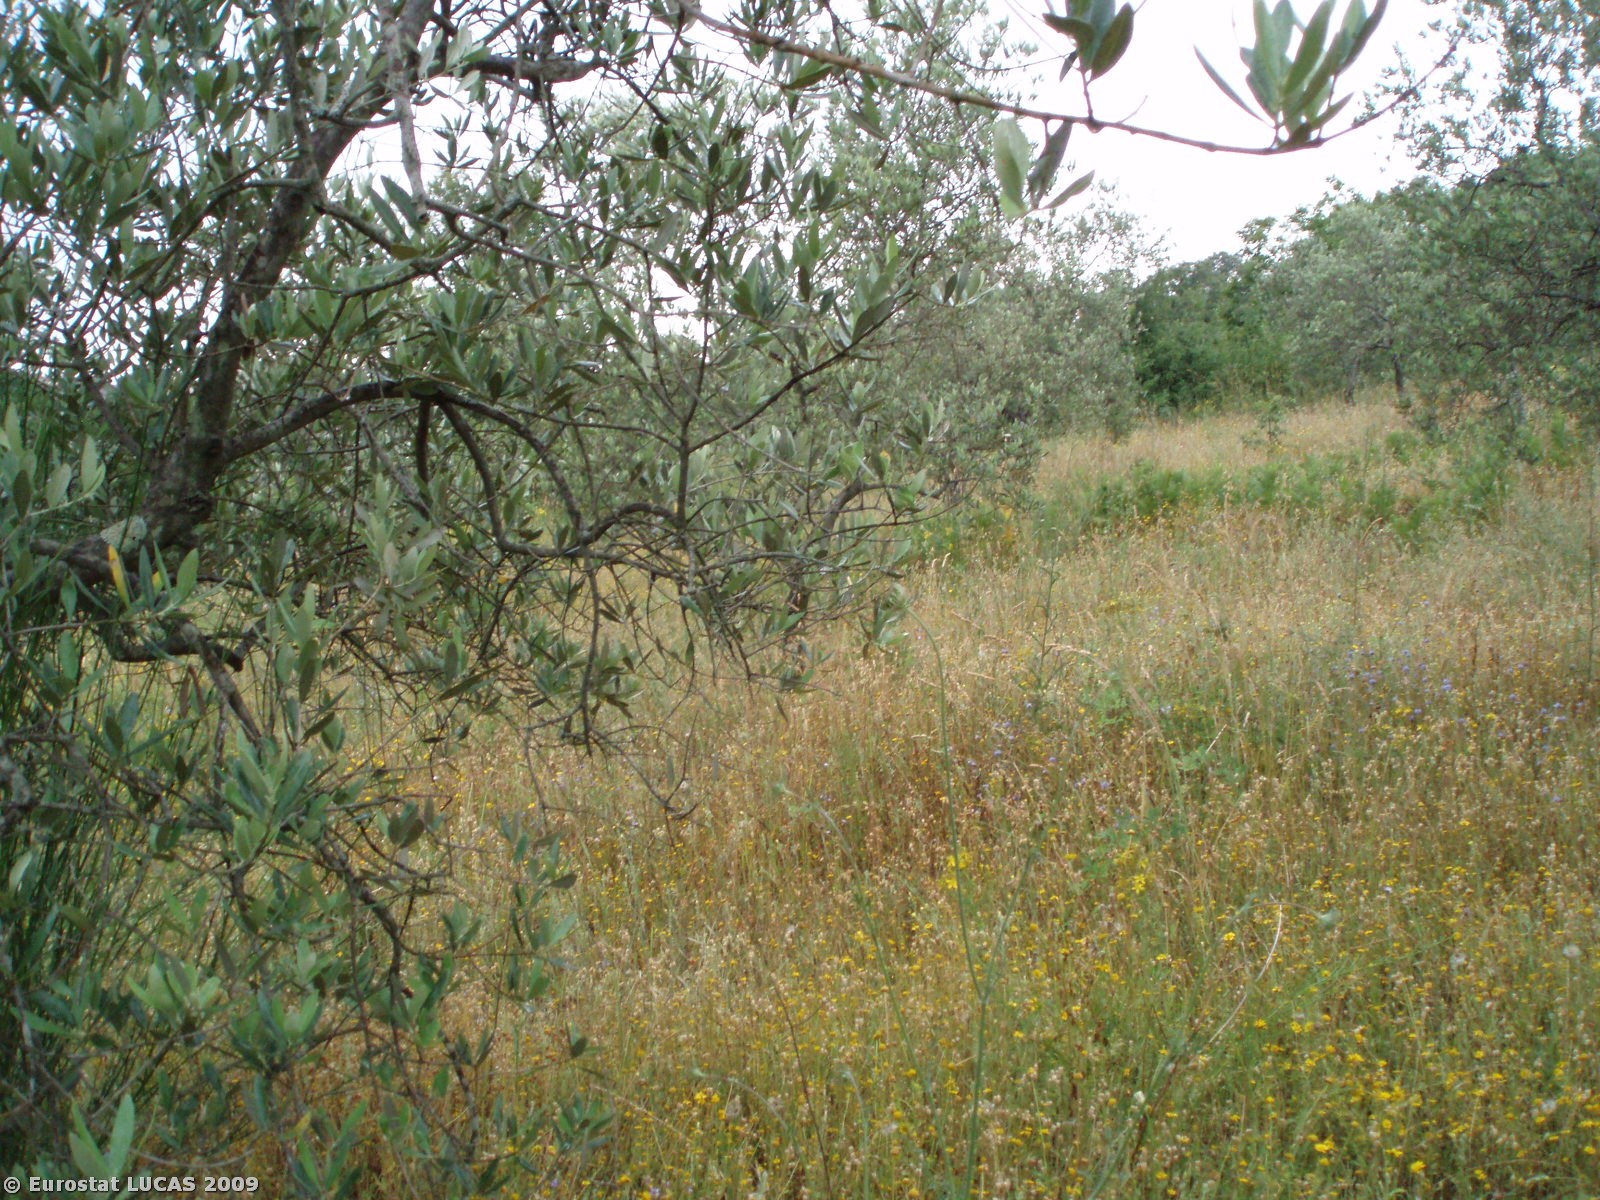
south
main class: Shrubland
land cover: Shrubland with sparse tree cover
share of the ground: > 75 %
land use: Fallow land
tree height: > 5 m
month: June
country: IT
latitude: 42.6776
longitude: 11.5934
